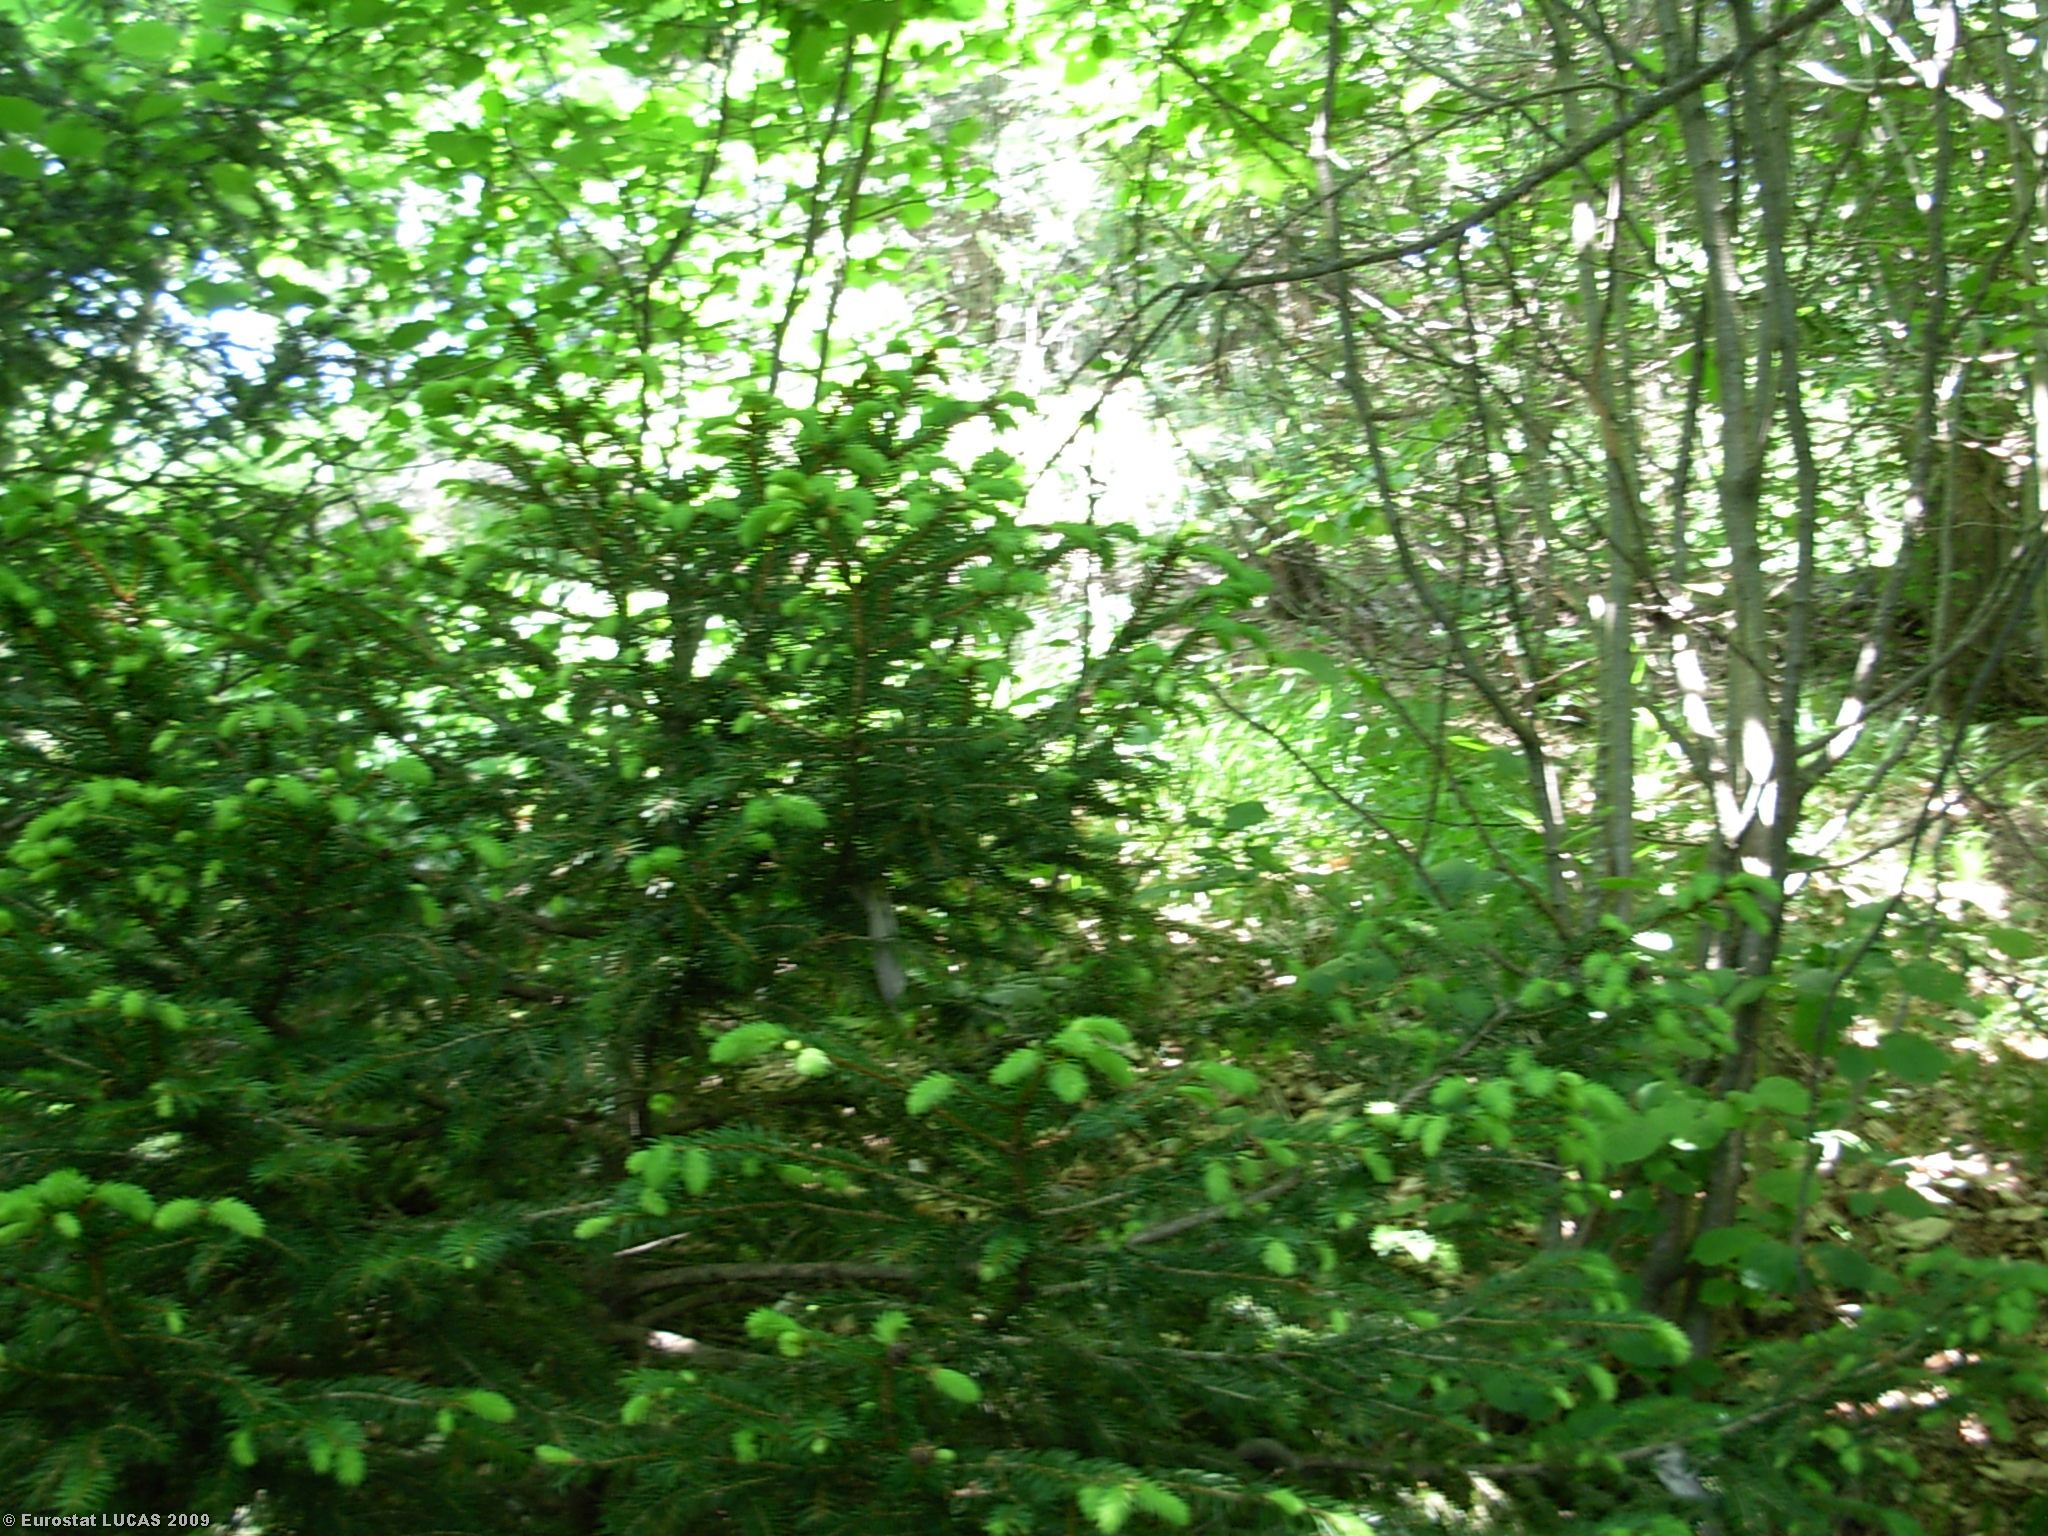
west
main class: Woodland
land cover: Broadleaved woodland
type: mountainous beech forest
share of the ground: > 75 %
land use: Unused
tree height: > 5 m
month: June
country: IT
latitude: 45.7195
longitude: 10.5002
